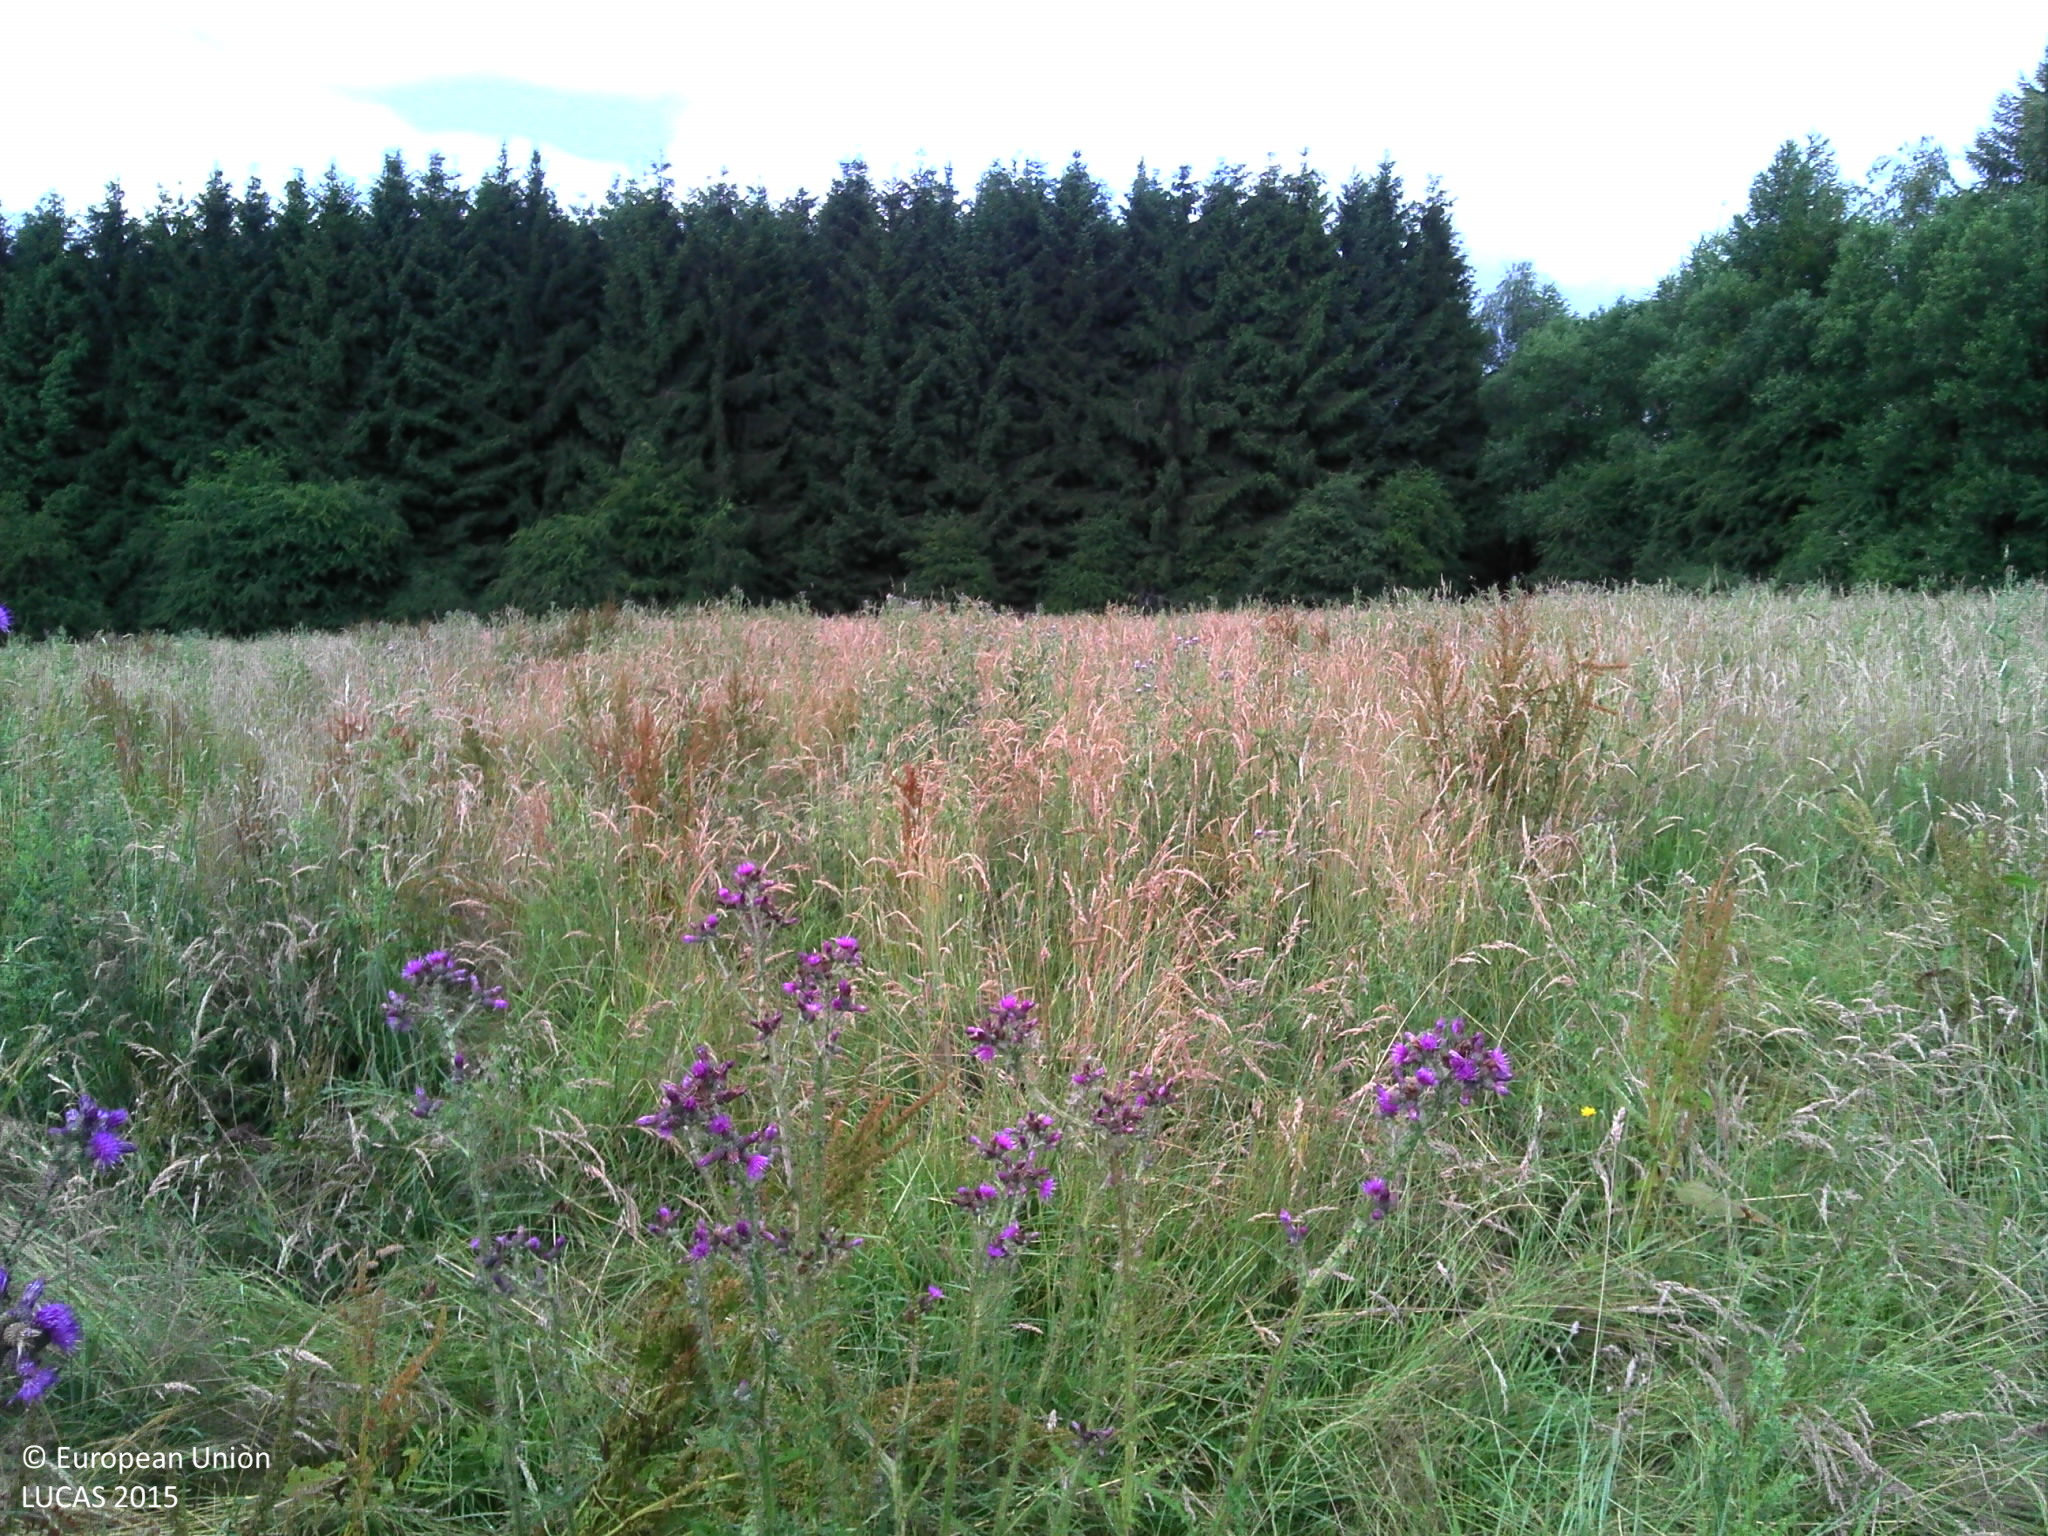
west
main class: Grassland
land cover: Grassland without tree/shrub cover
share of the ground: > 75 %
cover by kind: herbaceous plants 100 %
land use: Agriculture (excluding fallow land and kitchen gardens)
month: July
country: BE
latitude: 49.8681
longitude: 5.2257
